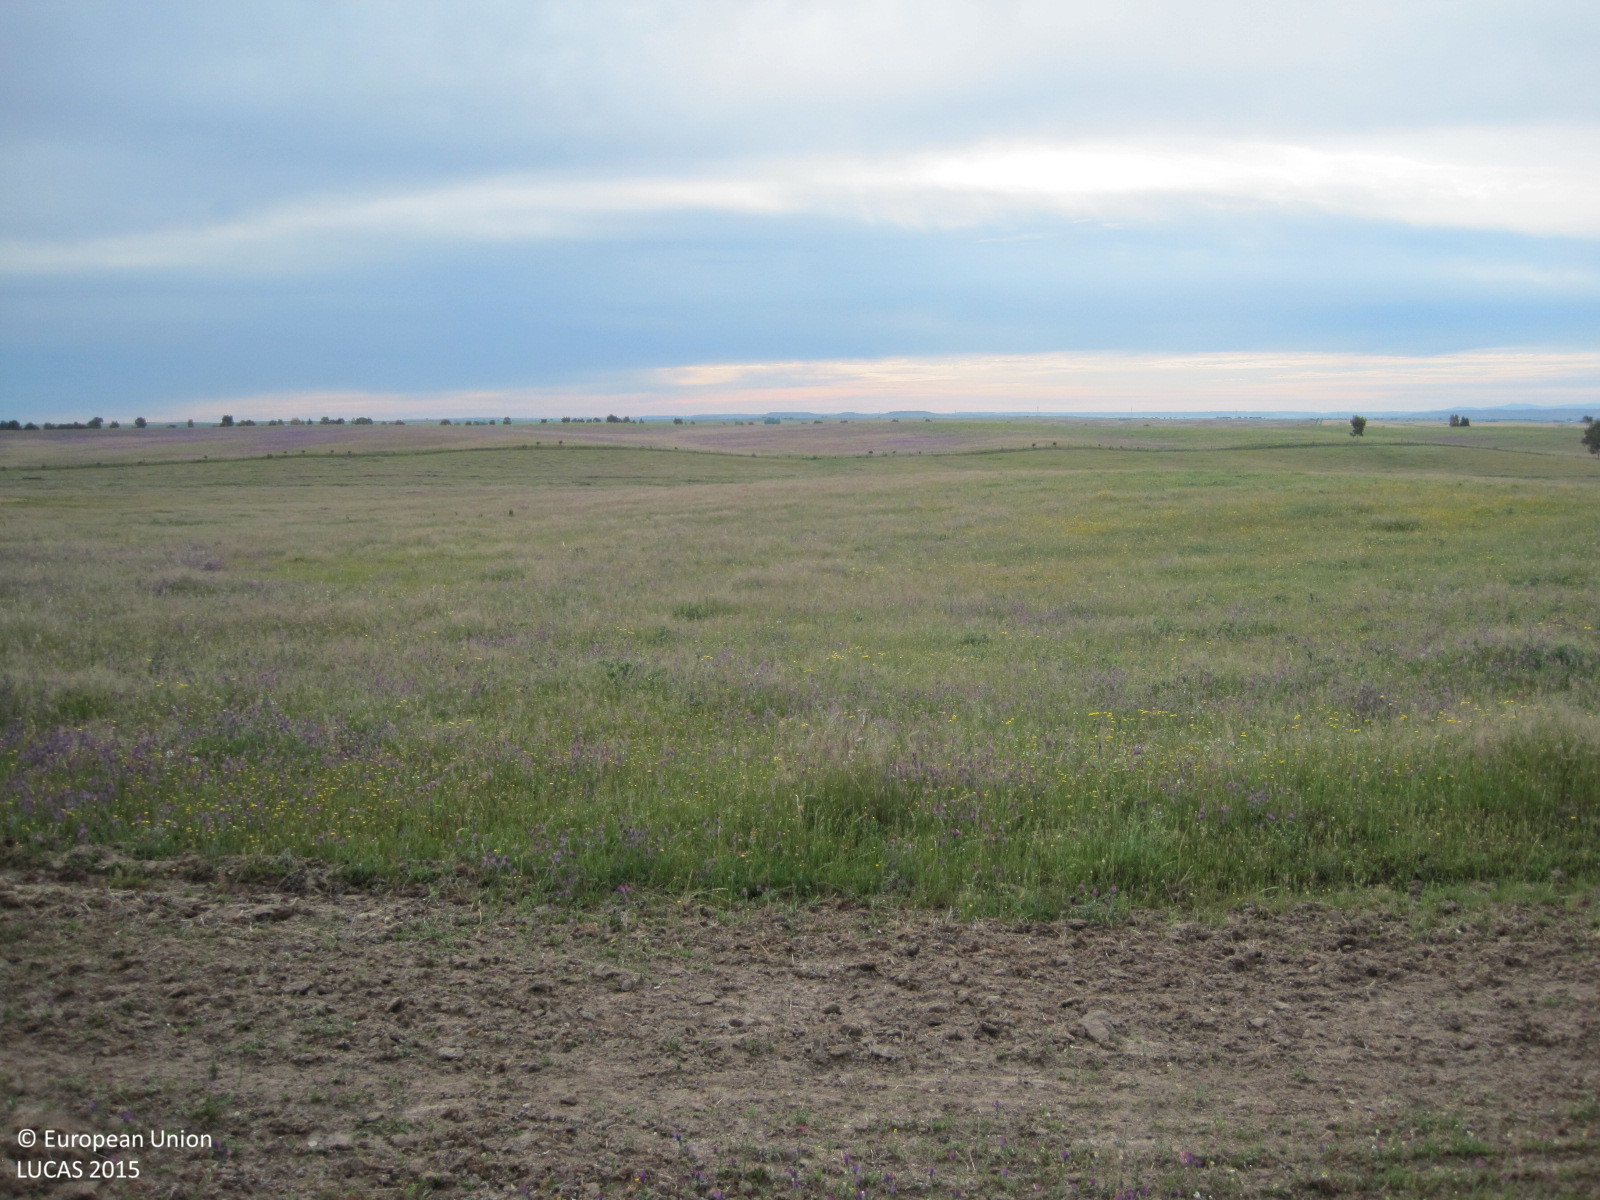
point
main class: Grassland
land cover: Grassland without tree/shrub cover
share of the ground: > 75 %
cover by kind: herbaceous plants 100 %
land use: Agriculture (excluding fallow land and kitchen gardens)
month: May
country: ES
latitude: 39.8597
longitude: -5.1186
